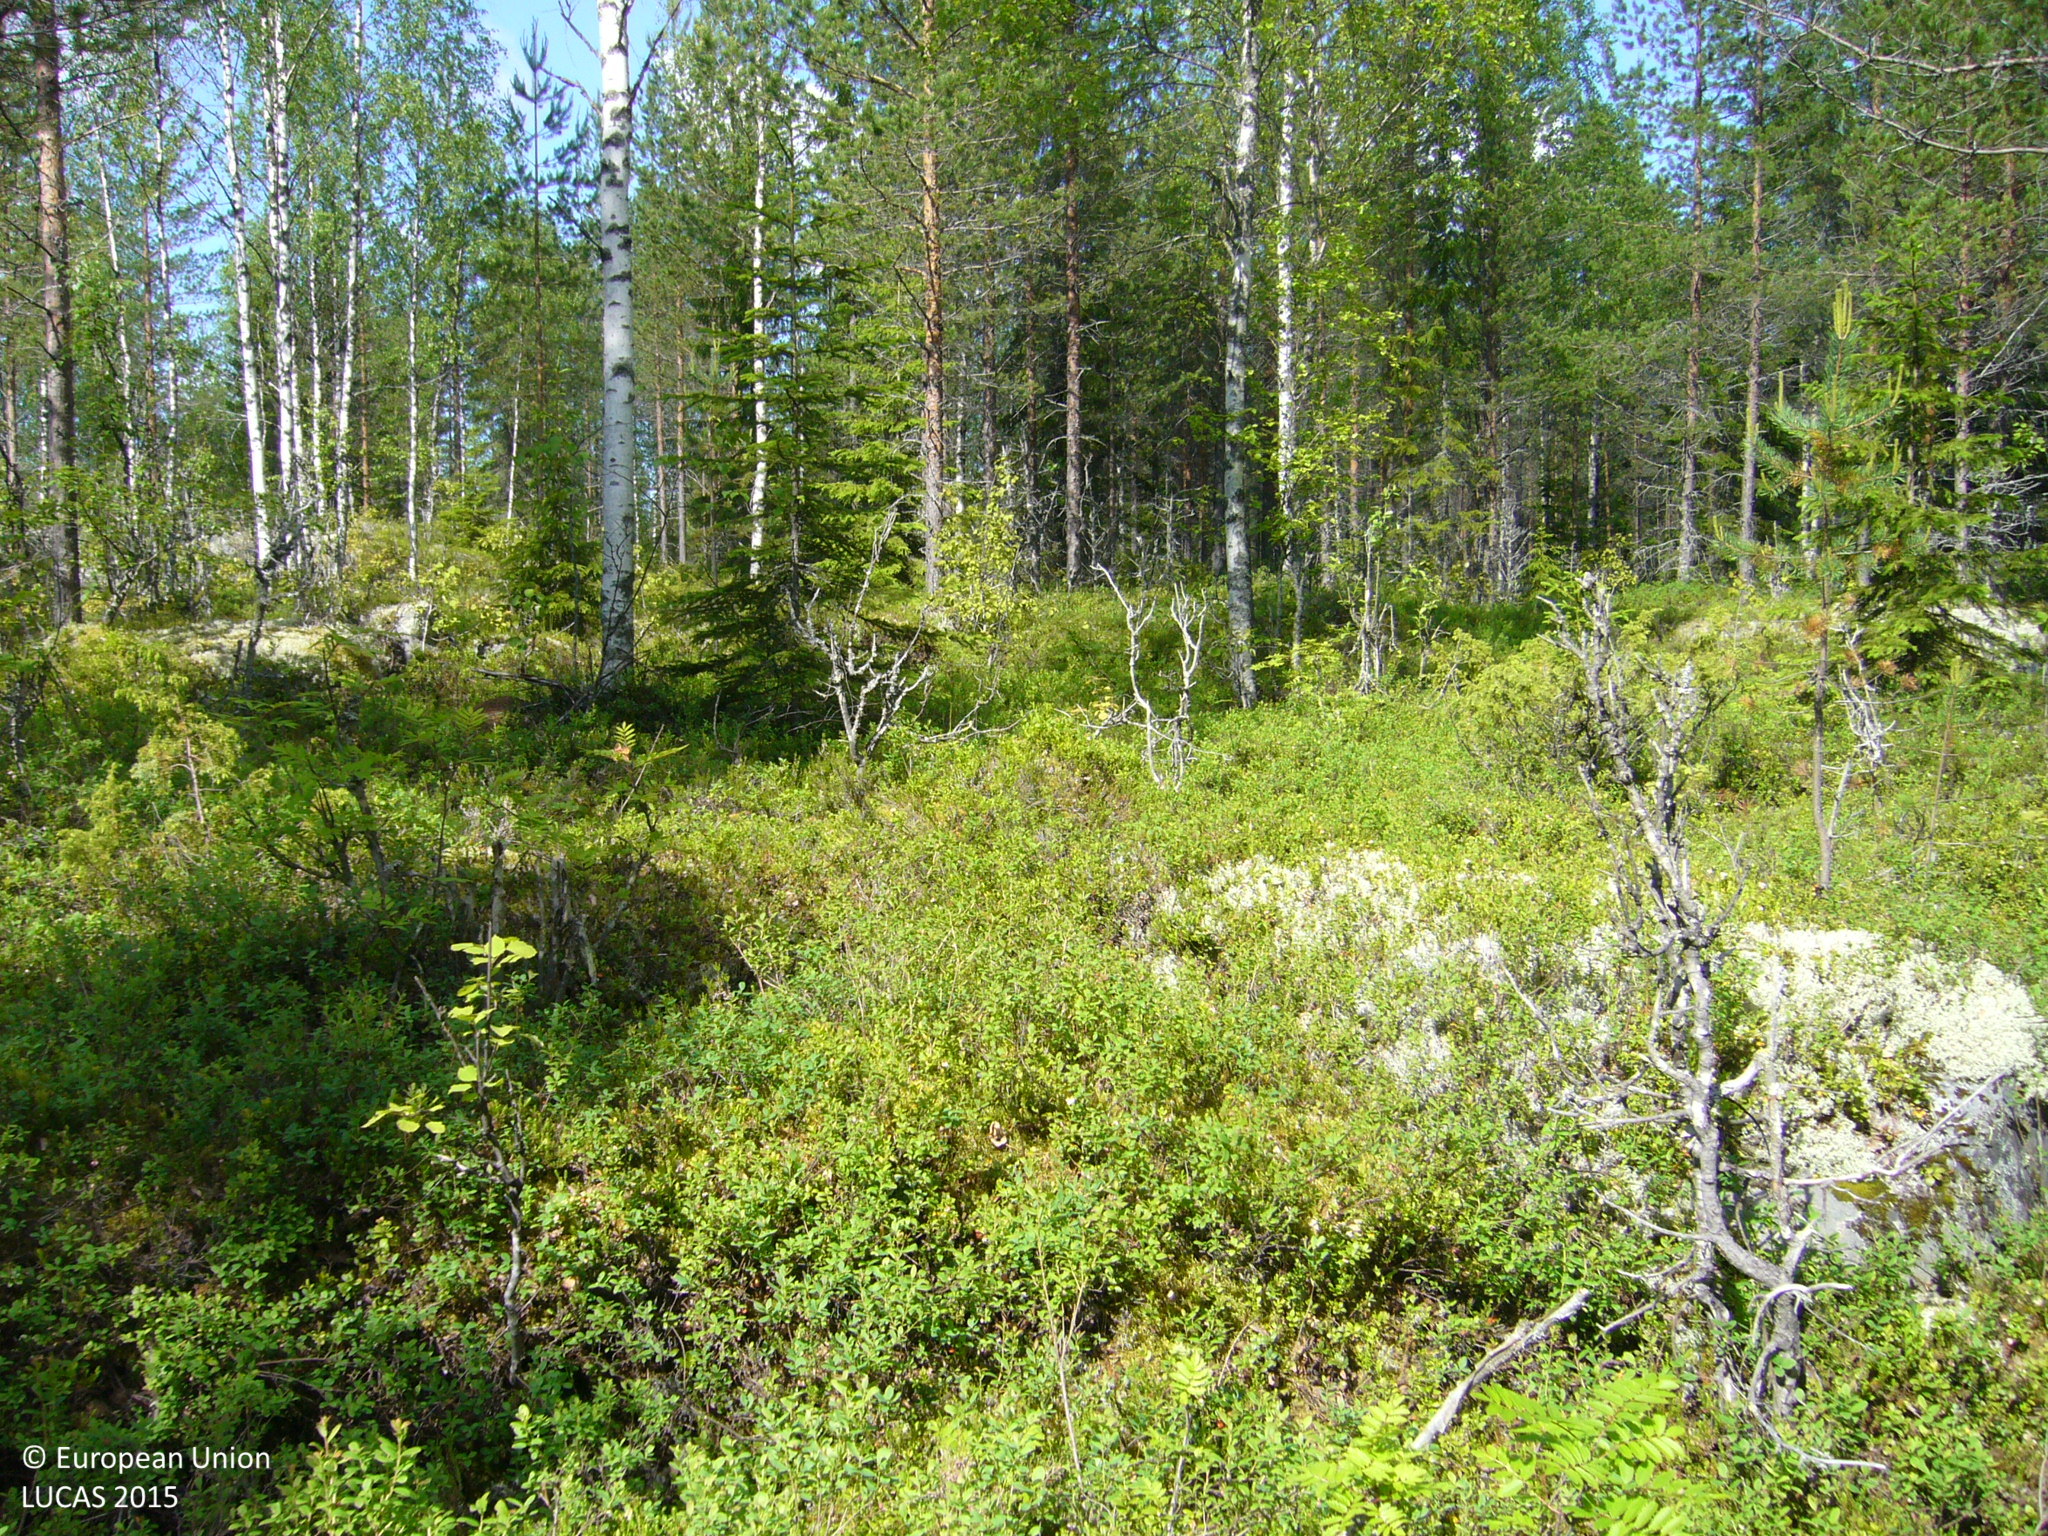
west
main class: Woodland
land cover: Pine dominated mixed woodland
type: boreal forest
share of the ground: 50 - 75 %
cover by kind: coniferous forest trees 45 %, shrubs 30 %, broadleaved forest trees 25 %
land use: Forestry
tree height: > 5 m
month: June
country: FI
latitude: 63.8071
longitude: 26.6355
